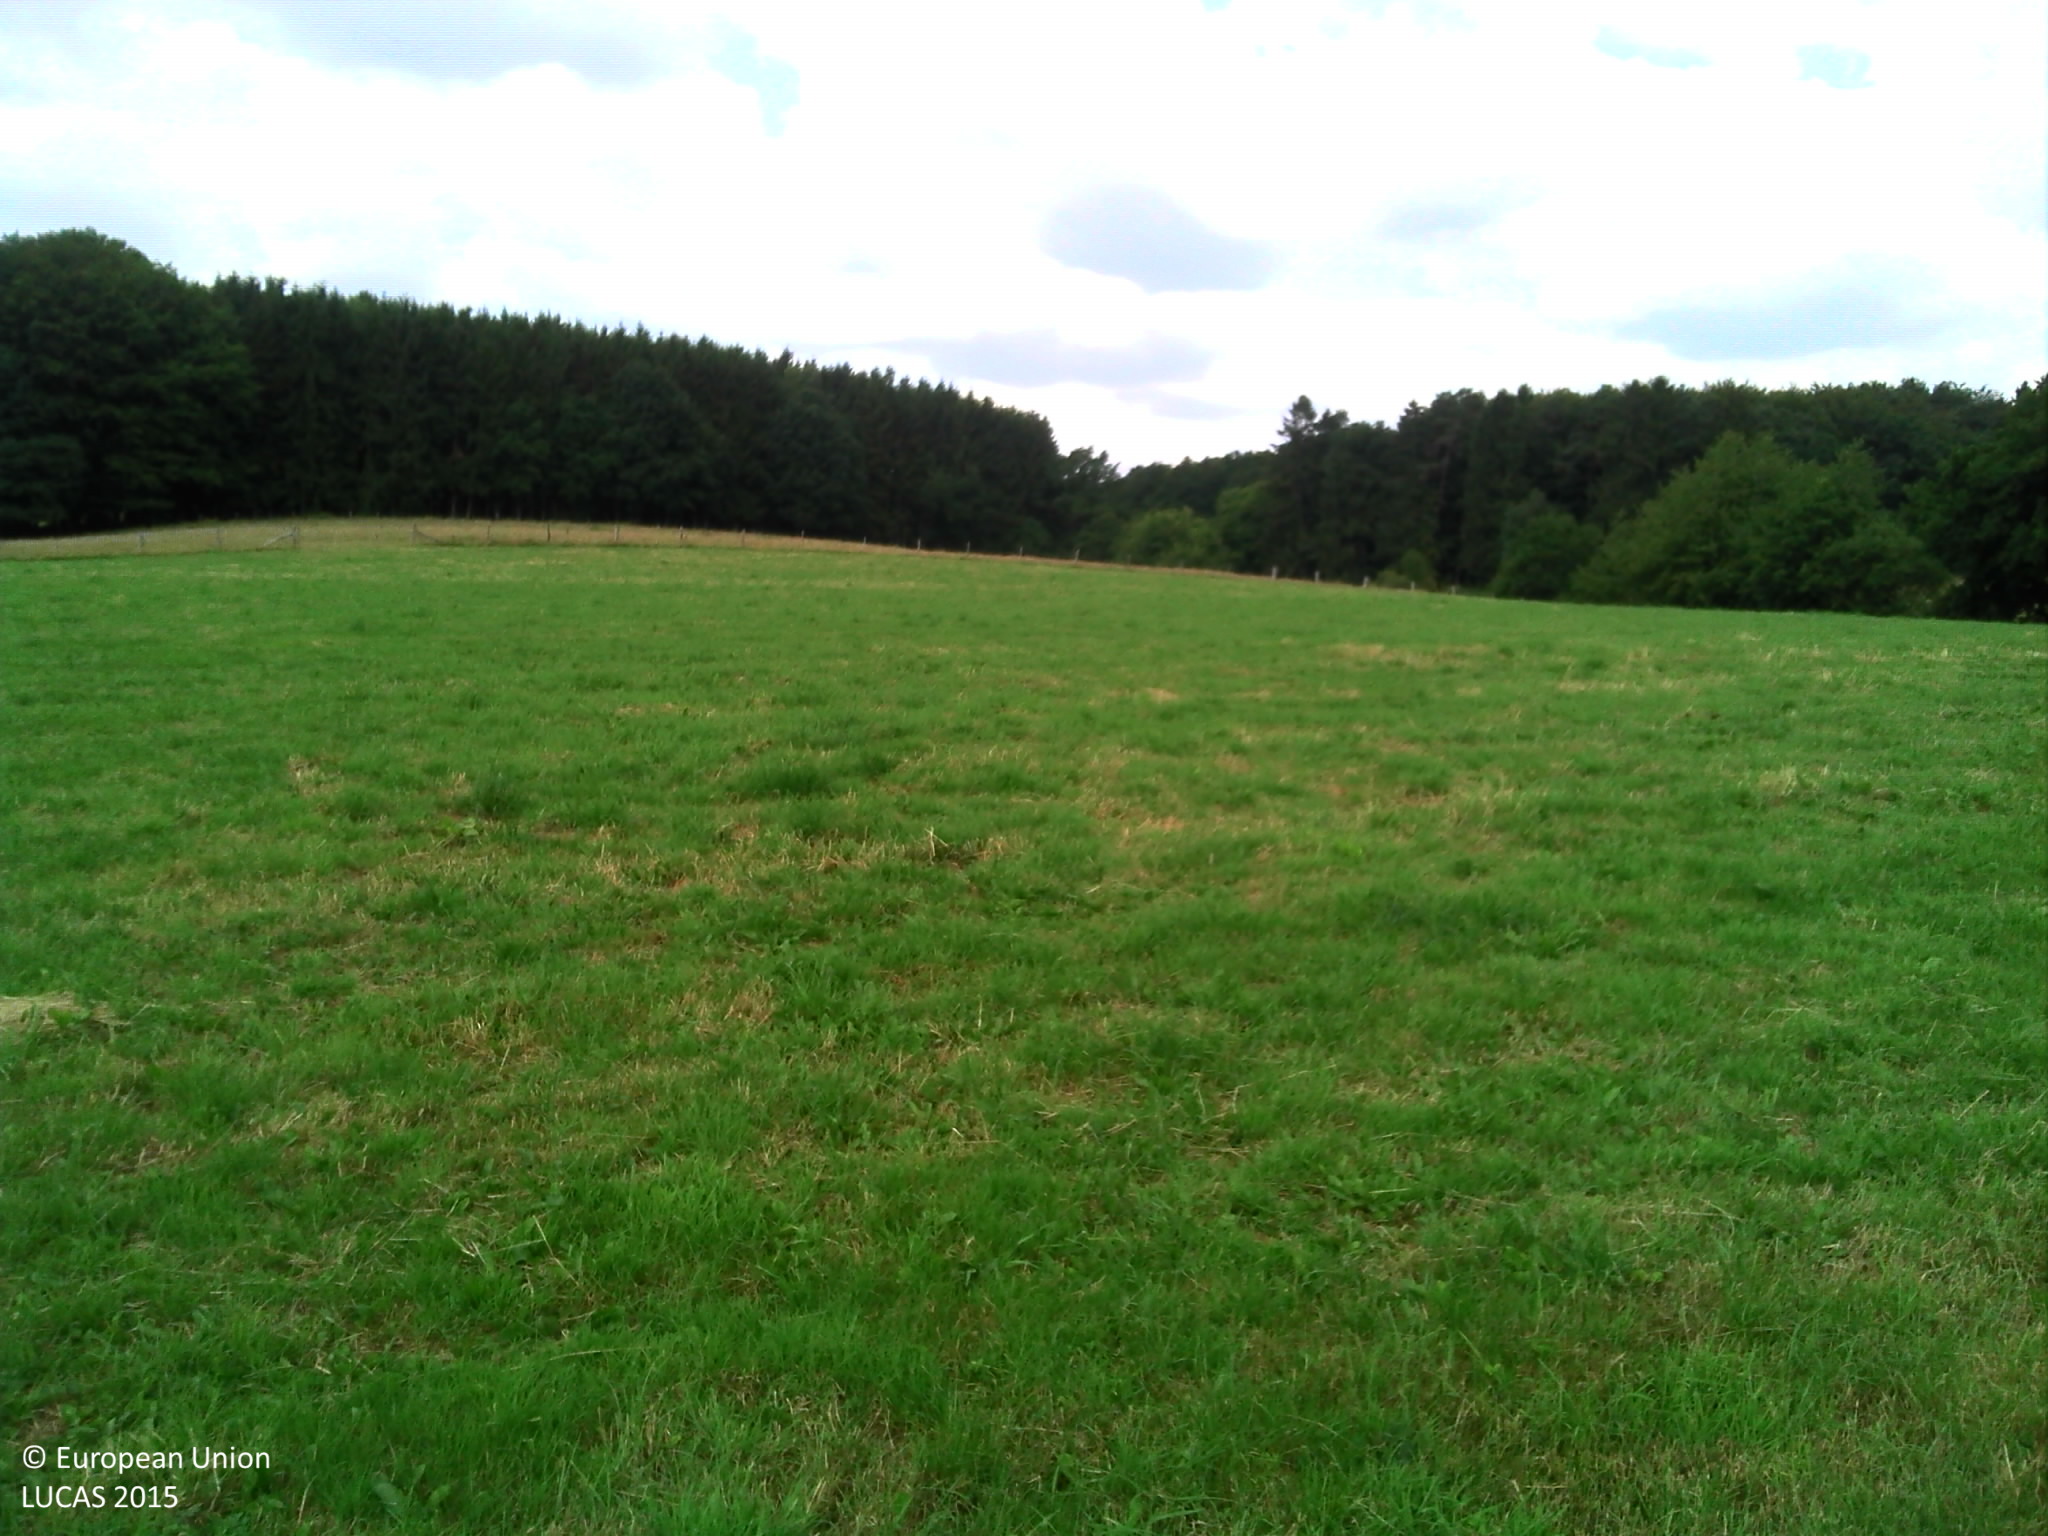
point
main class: Grassland
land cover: Grassland without tree/shrub cover
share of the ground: > 75 %
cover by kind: herbaceous plants 100 %
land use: Agriculture (excluding fallow land and kitchen gardens)
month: June
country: LU
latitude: 49.8443
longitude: 6.0081
